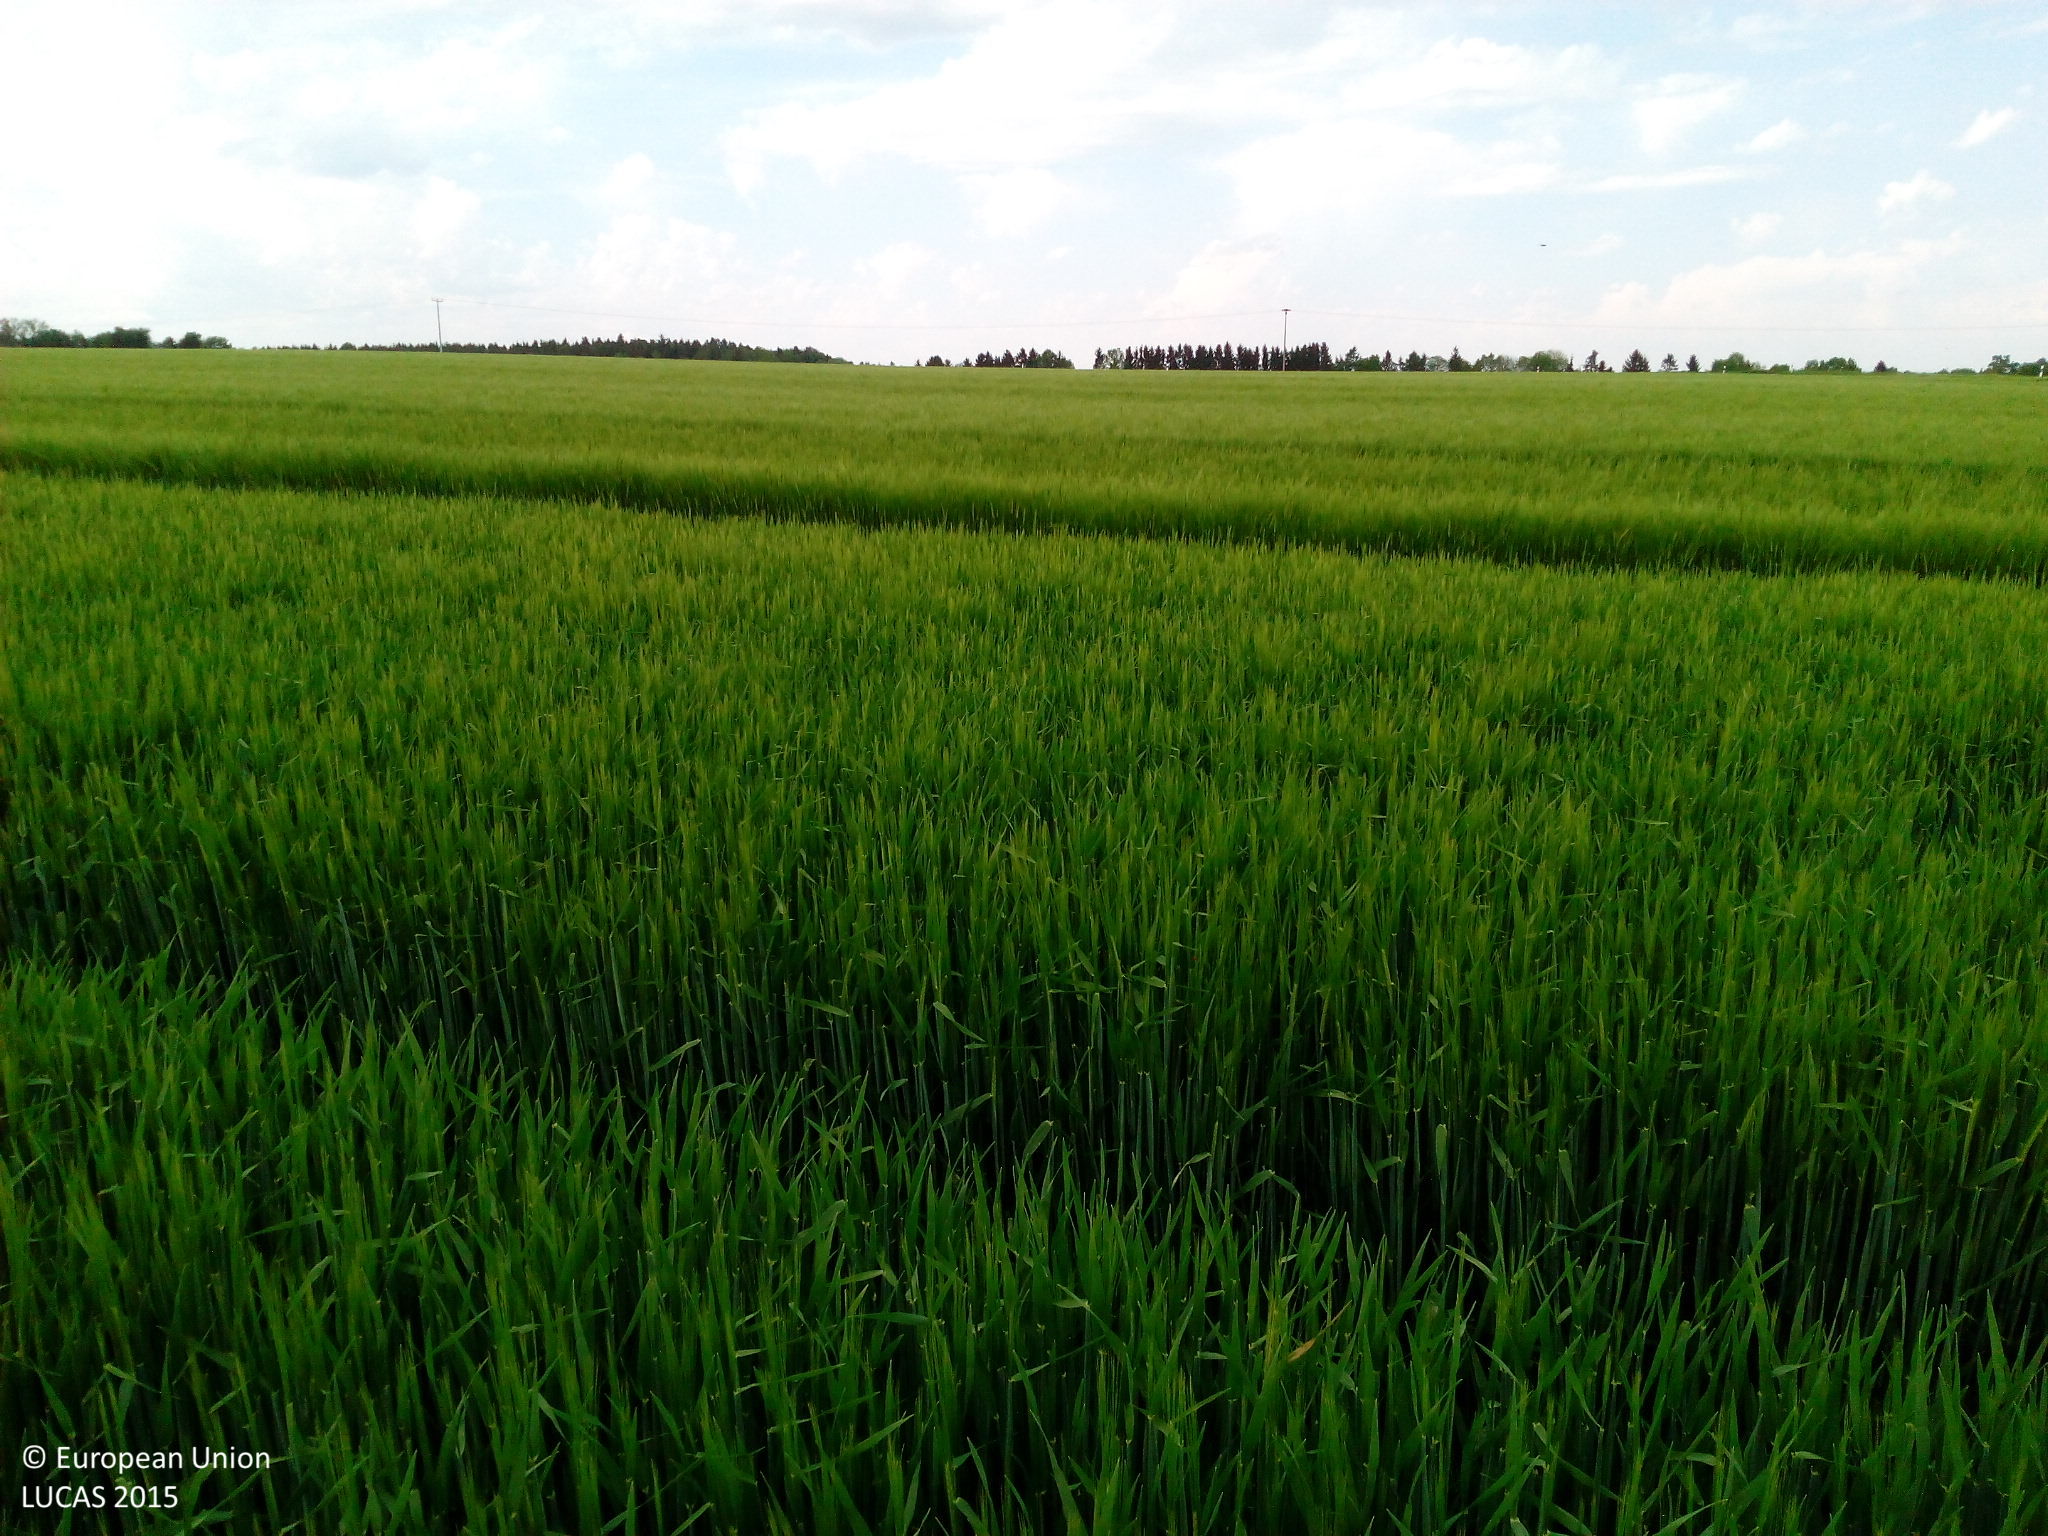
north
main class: Cropland
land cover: Barley
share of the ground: > 75 %
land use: Agriculture (excluding fallow land and kitchen gardens)
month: May
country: DE
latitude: 47.9875
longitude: 9.3171
